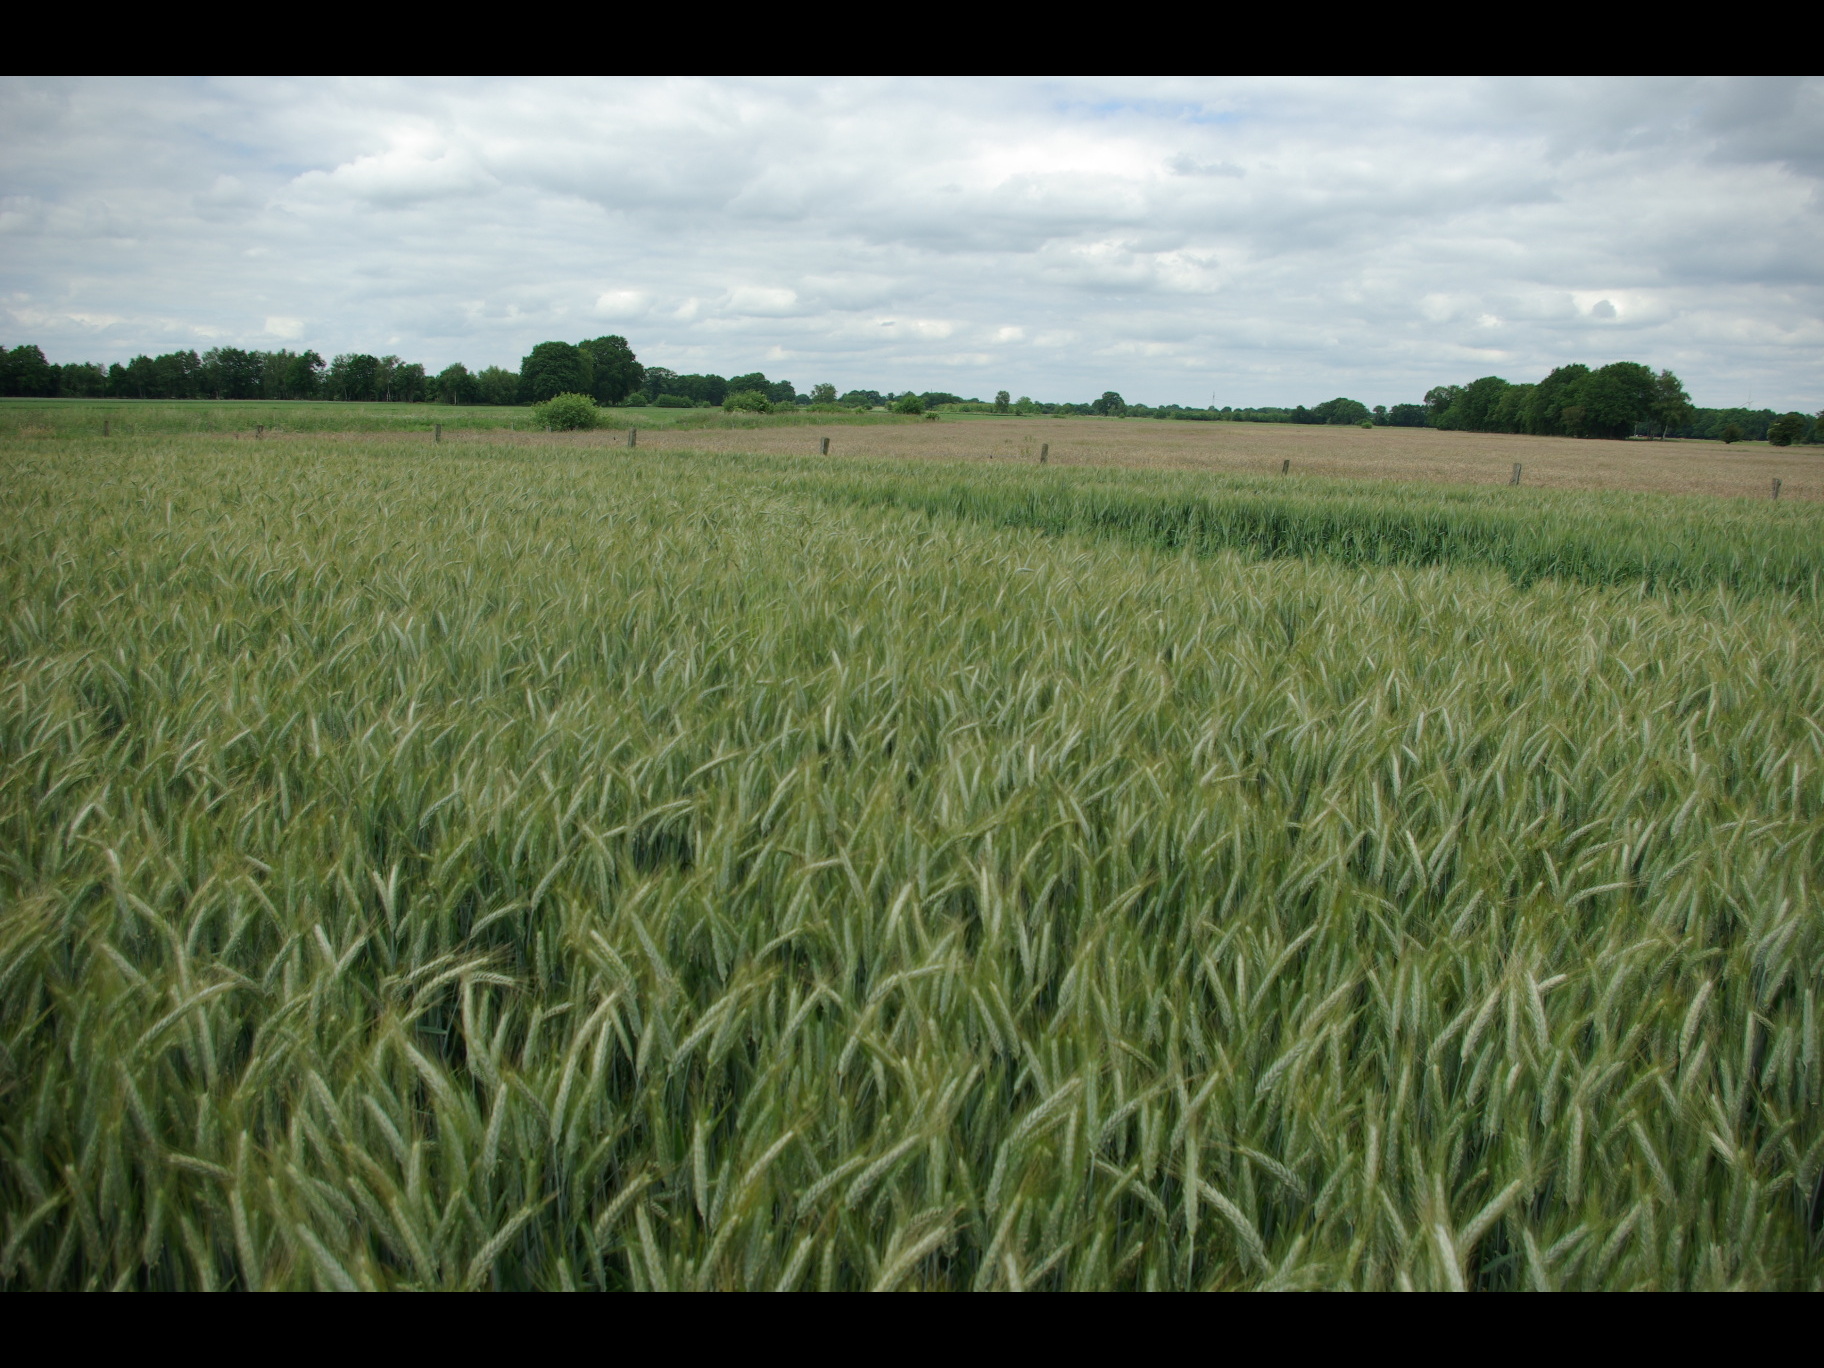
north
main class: Cropland
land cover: Triticale
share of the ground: > 75 %
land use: Agriculture (excluding fallow land and kitchen gardens)
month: June
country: DE
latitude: 54.1028
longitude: 9.9236
